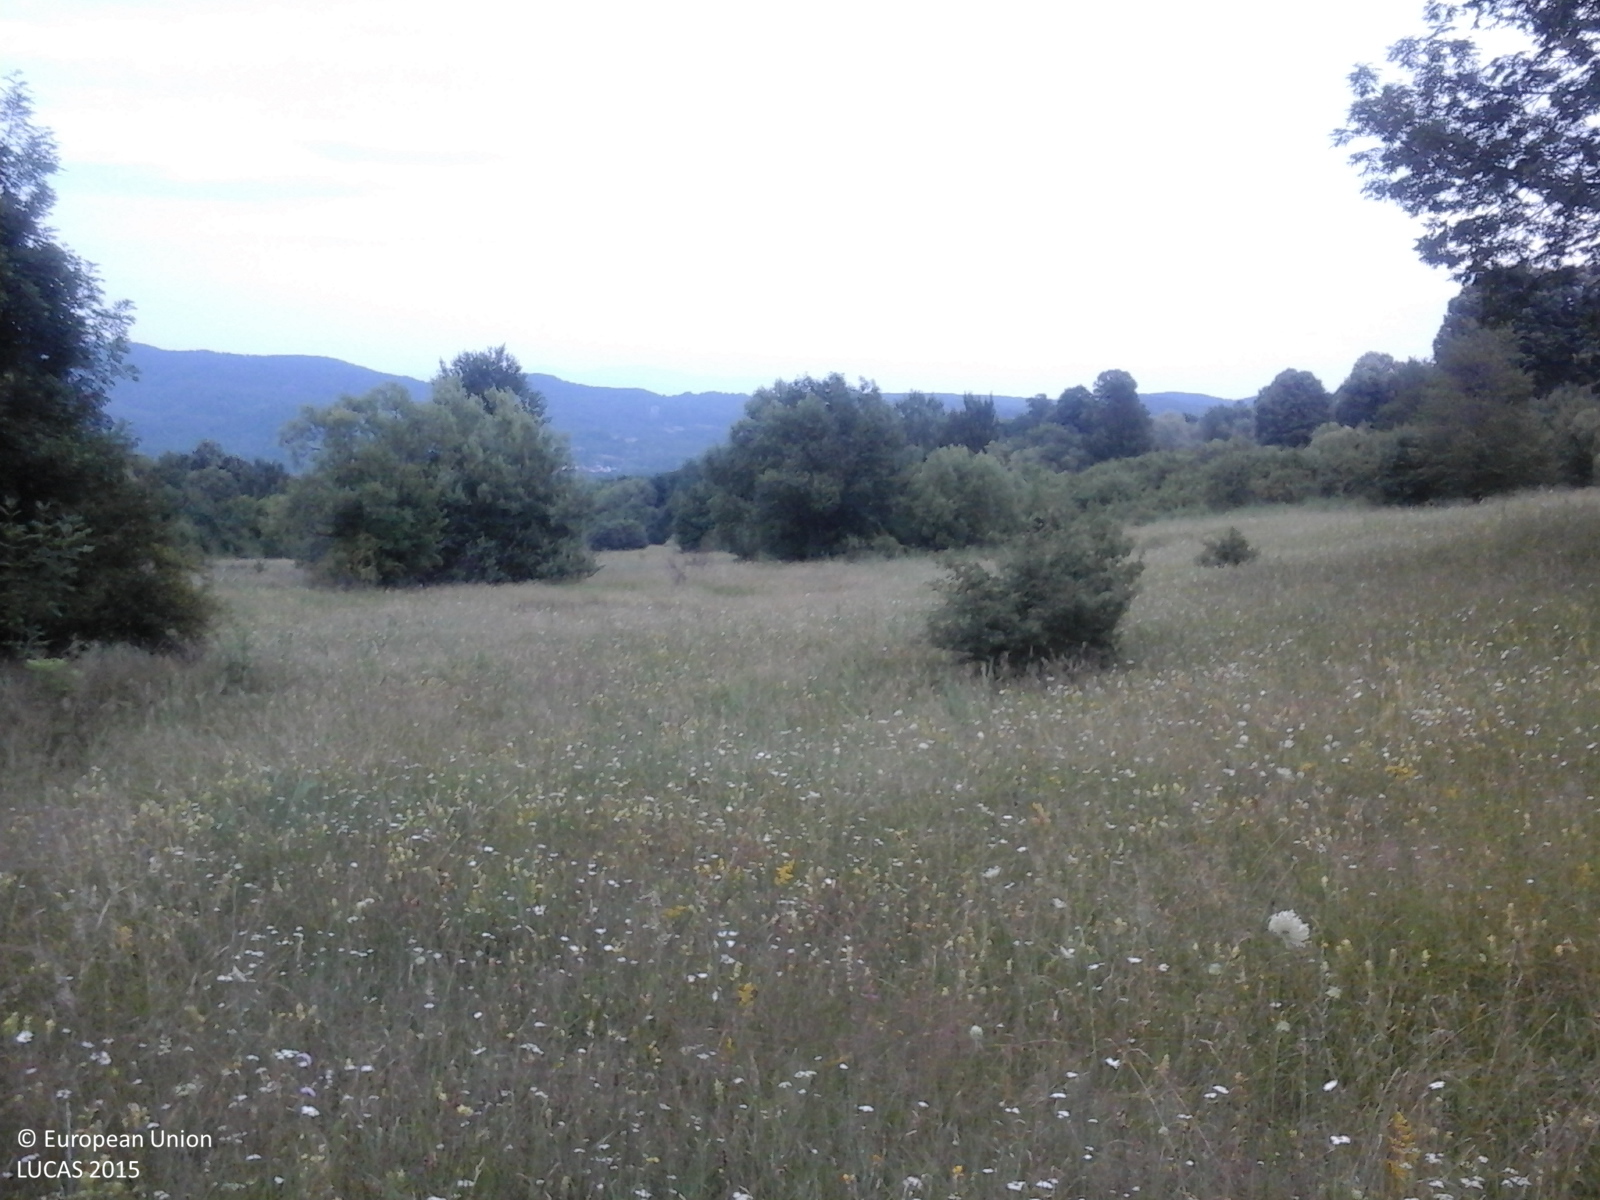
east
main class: Grassland
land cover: Grassland with sparse tree/shrub cover
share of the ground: > 75 %
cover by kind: herbaceous plants 90 %, broadleaved forest trees 5 %, shrubs 5 %
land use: Agriculture (excluding fallow land and kitchen gardens)
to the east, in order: Grassland with sparse tree/shrub cover; Grassland without tree/shrub cover; Grassland with sparse tree/shrub cover; Broadleaved woodland; Grassland with sparse tree/shrub cover; Grassland without tree/shrub cover
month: July
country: RO
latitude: 45.1924
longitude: 24.7582
